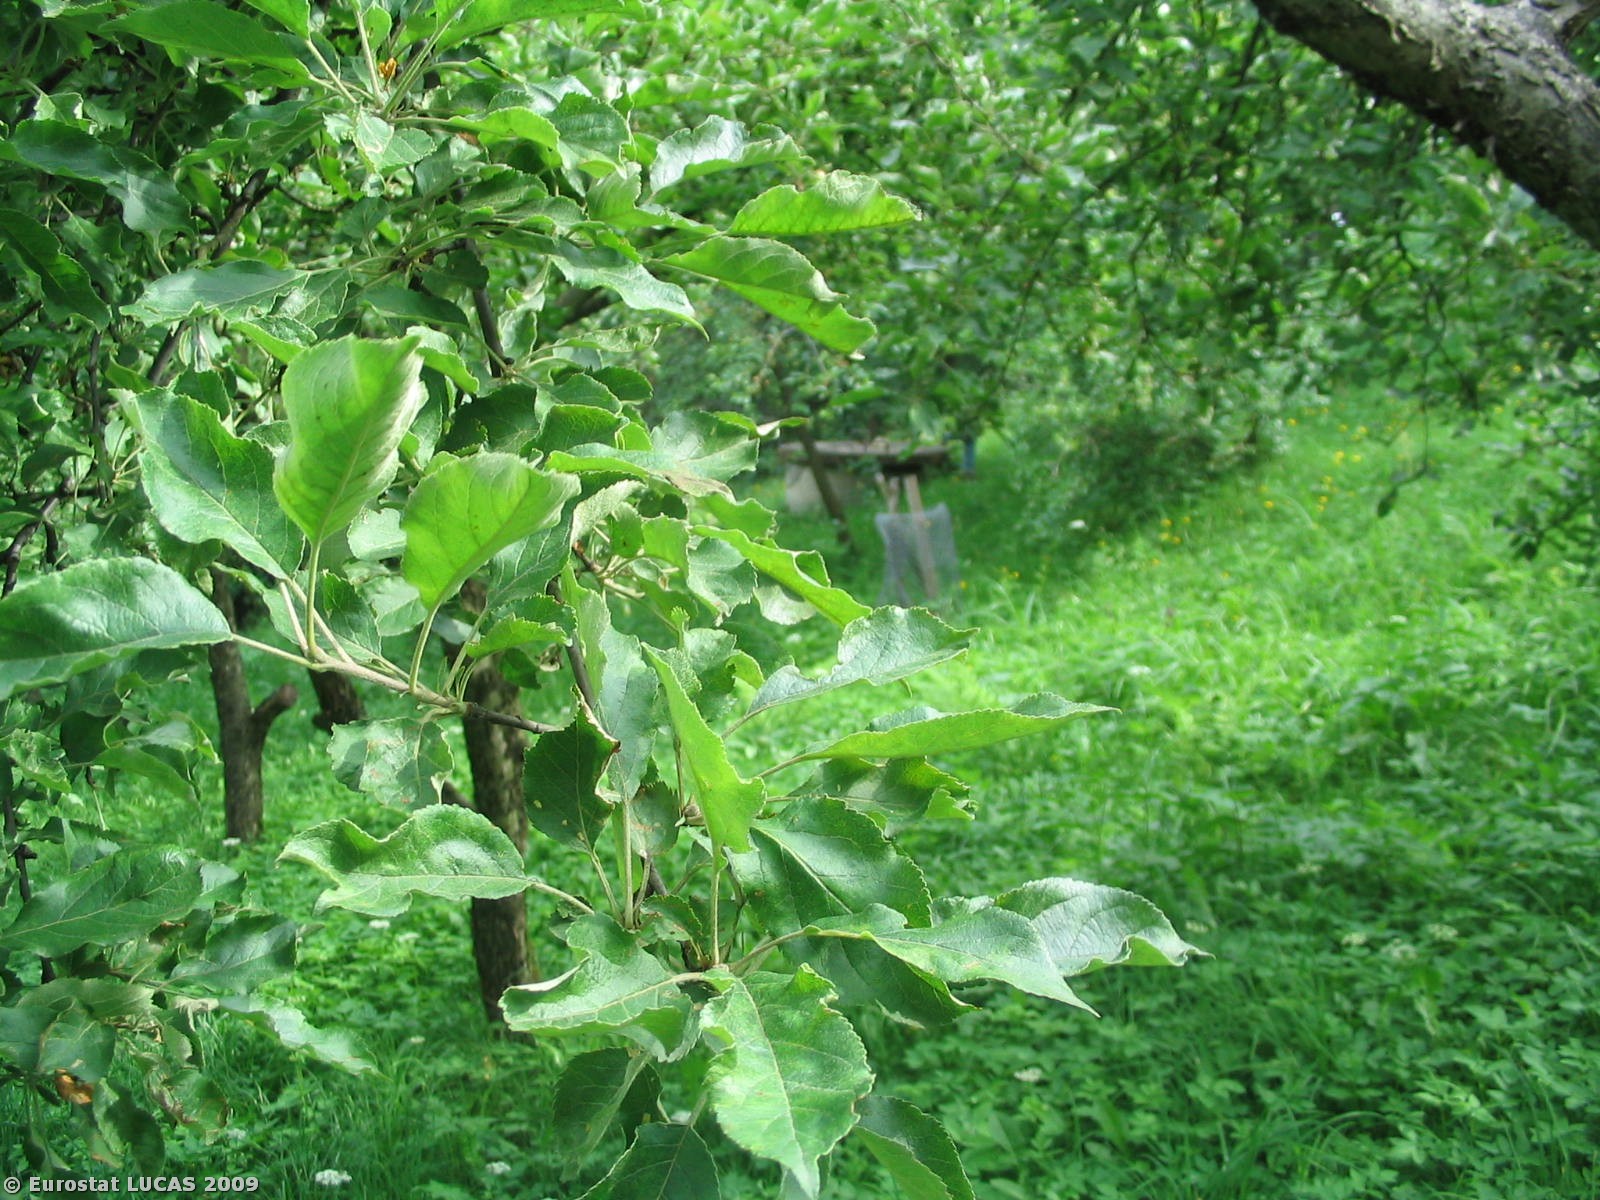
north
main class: Cropland
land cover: Apple fruit
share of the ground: 50 - 75 %
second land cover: Grassland with sparse tree/shrub cover
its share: > 75 %
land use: Kitchen garden
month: June
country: CZ
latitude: 49.5762
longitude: 18.7468
